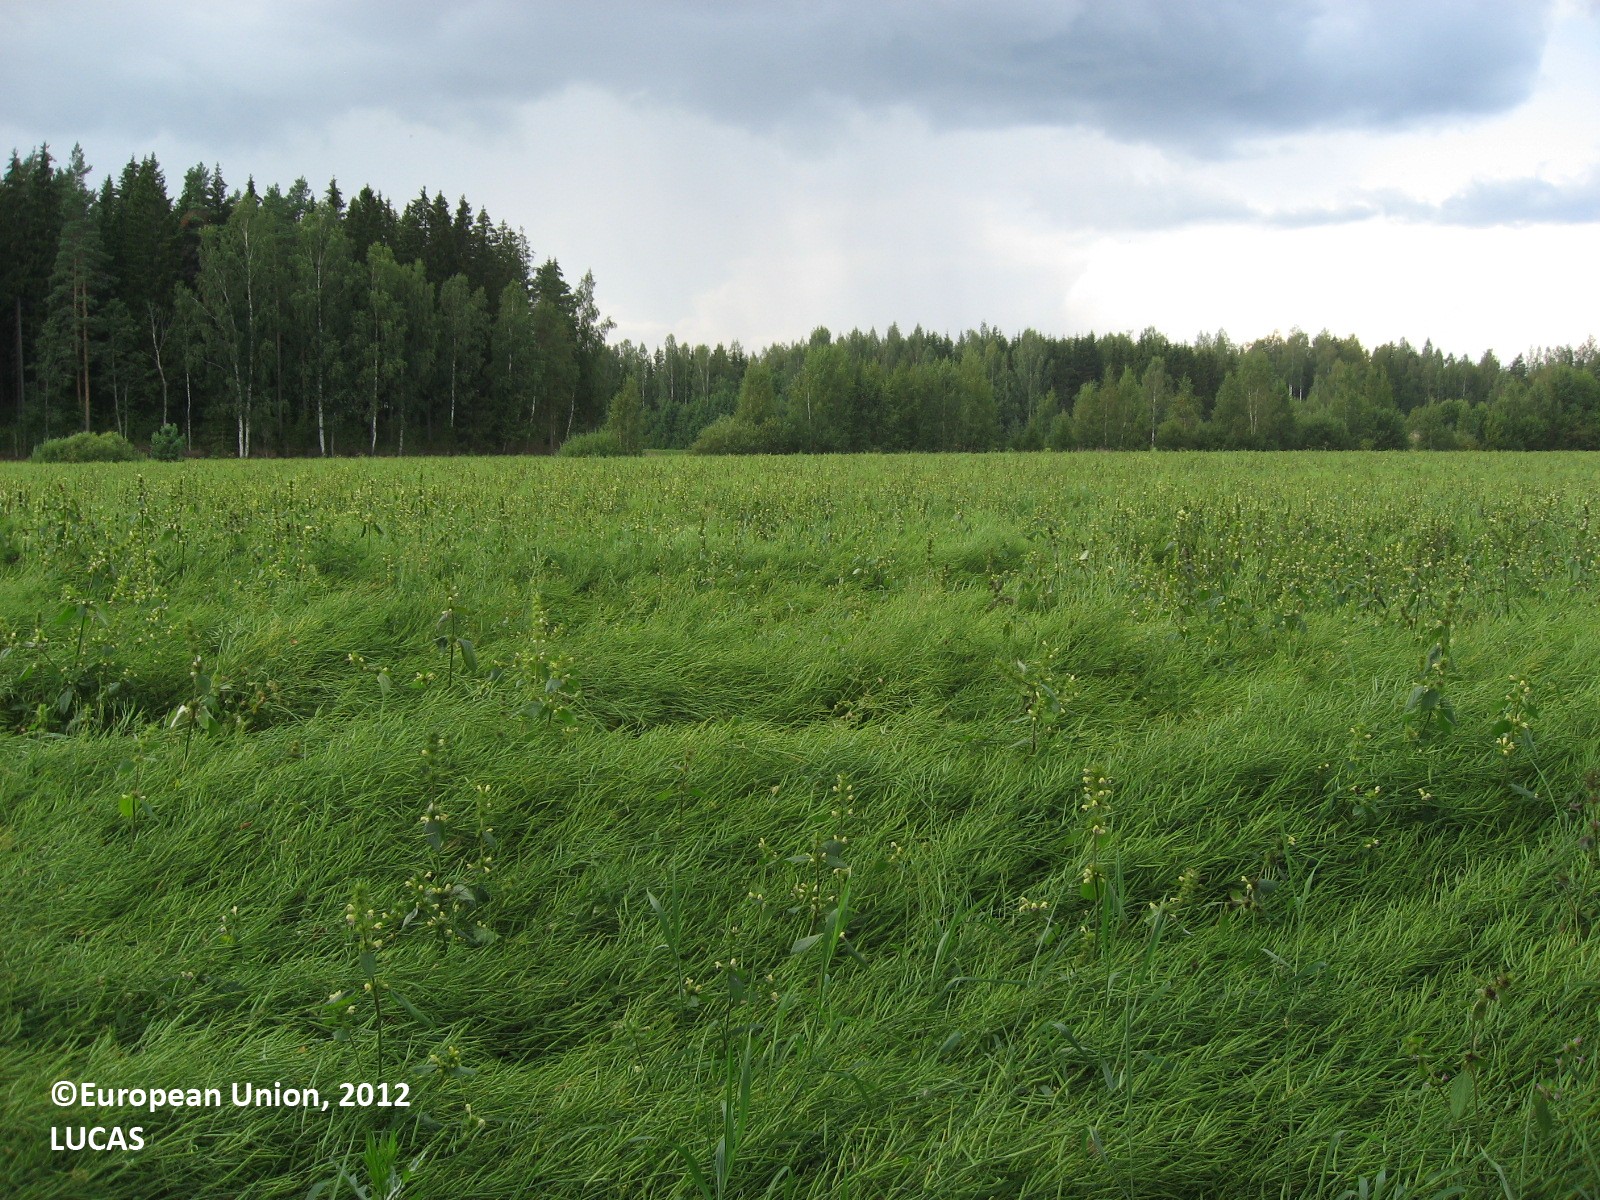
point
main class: Cropland
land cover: Rape and turnip rape
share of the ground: > 75 %
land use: Agriculture (excluding fallow land and kitchen gardens)
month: August
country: FI
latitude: 60.6541
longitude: 25.2124
